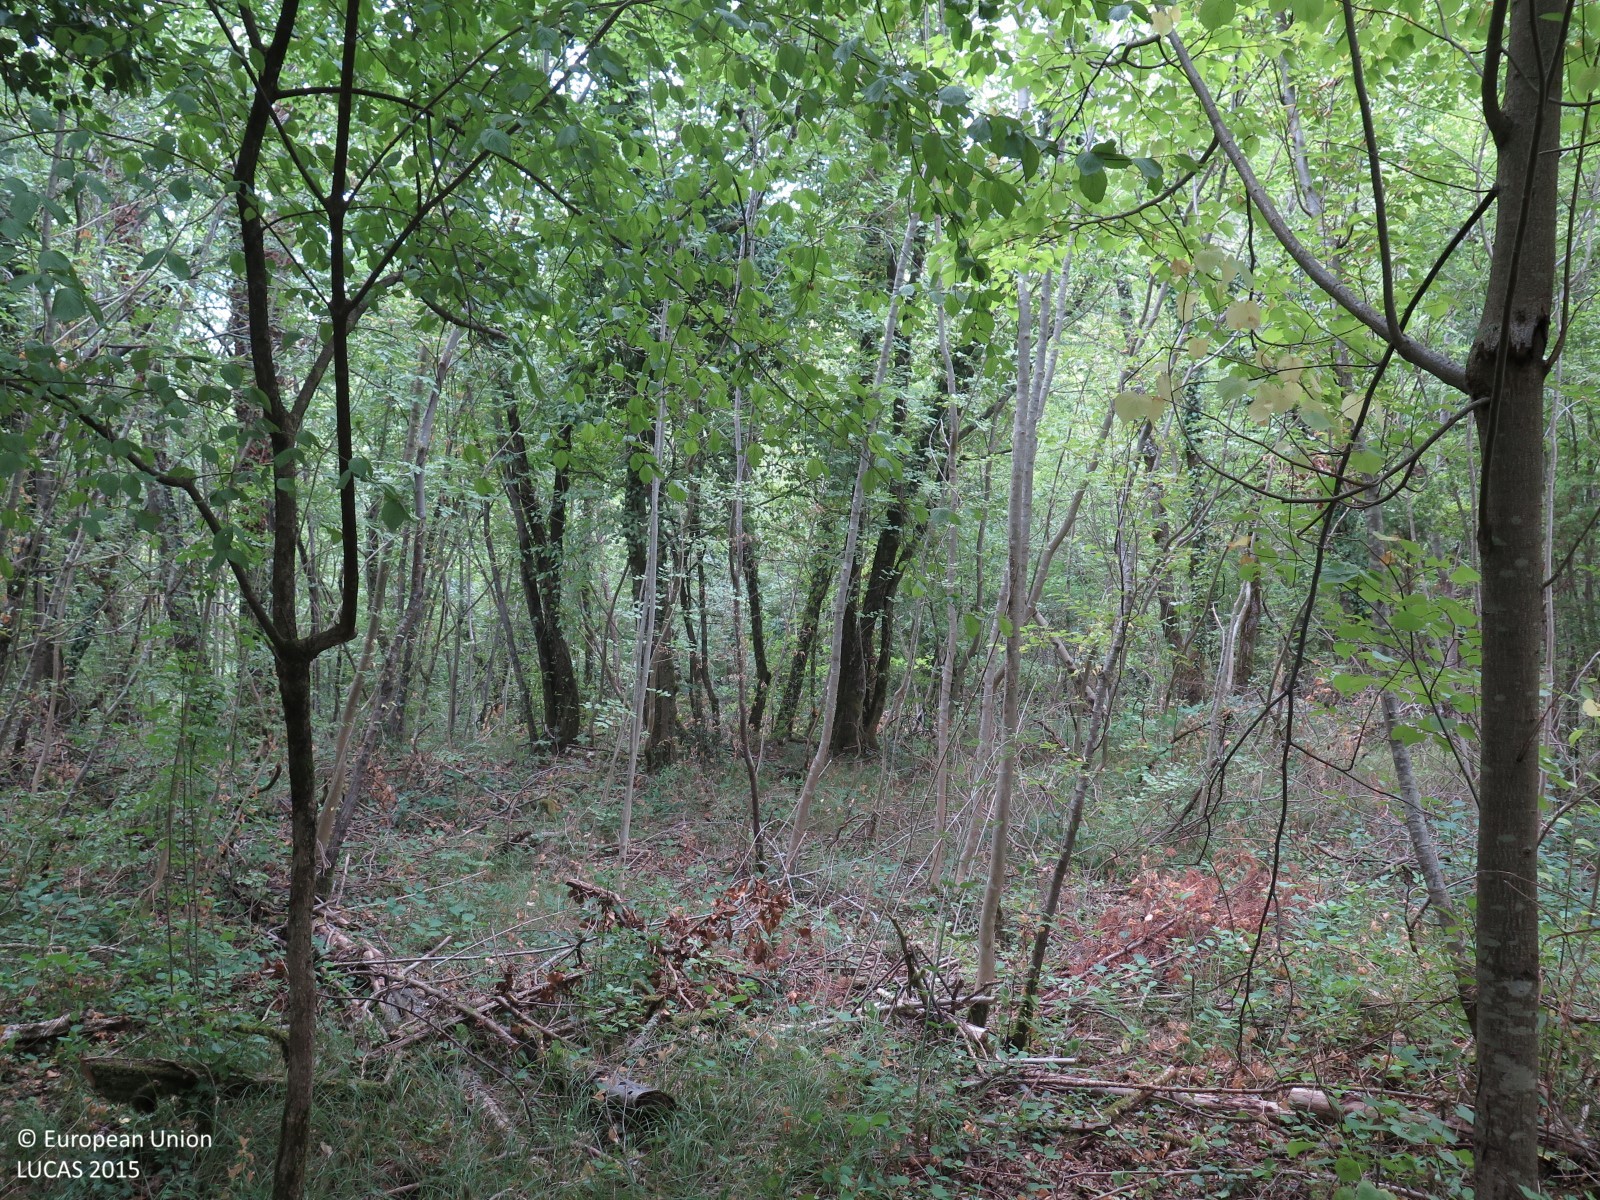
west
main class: Woodland
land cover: Broadleaved woodland
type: beech forest
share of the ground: > 75 %
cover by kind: broadleaved forest trees 95 %, herbaceous plants 5 %
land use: Forestry
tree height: > 5 m
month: July
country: HR
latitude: 45.3160
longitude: 14.1151
